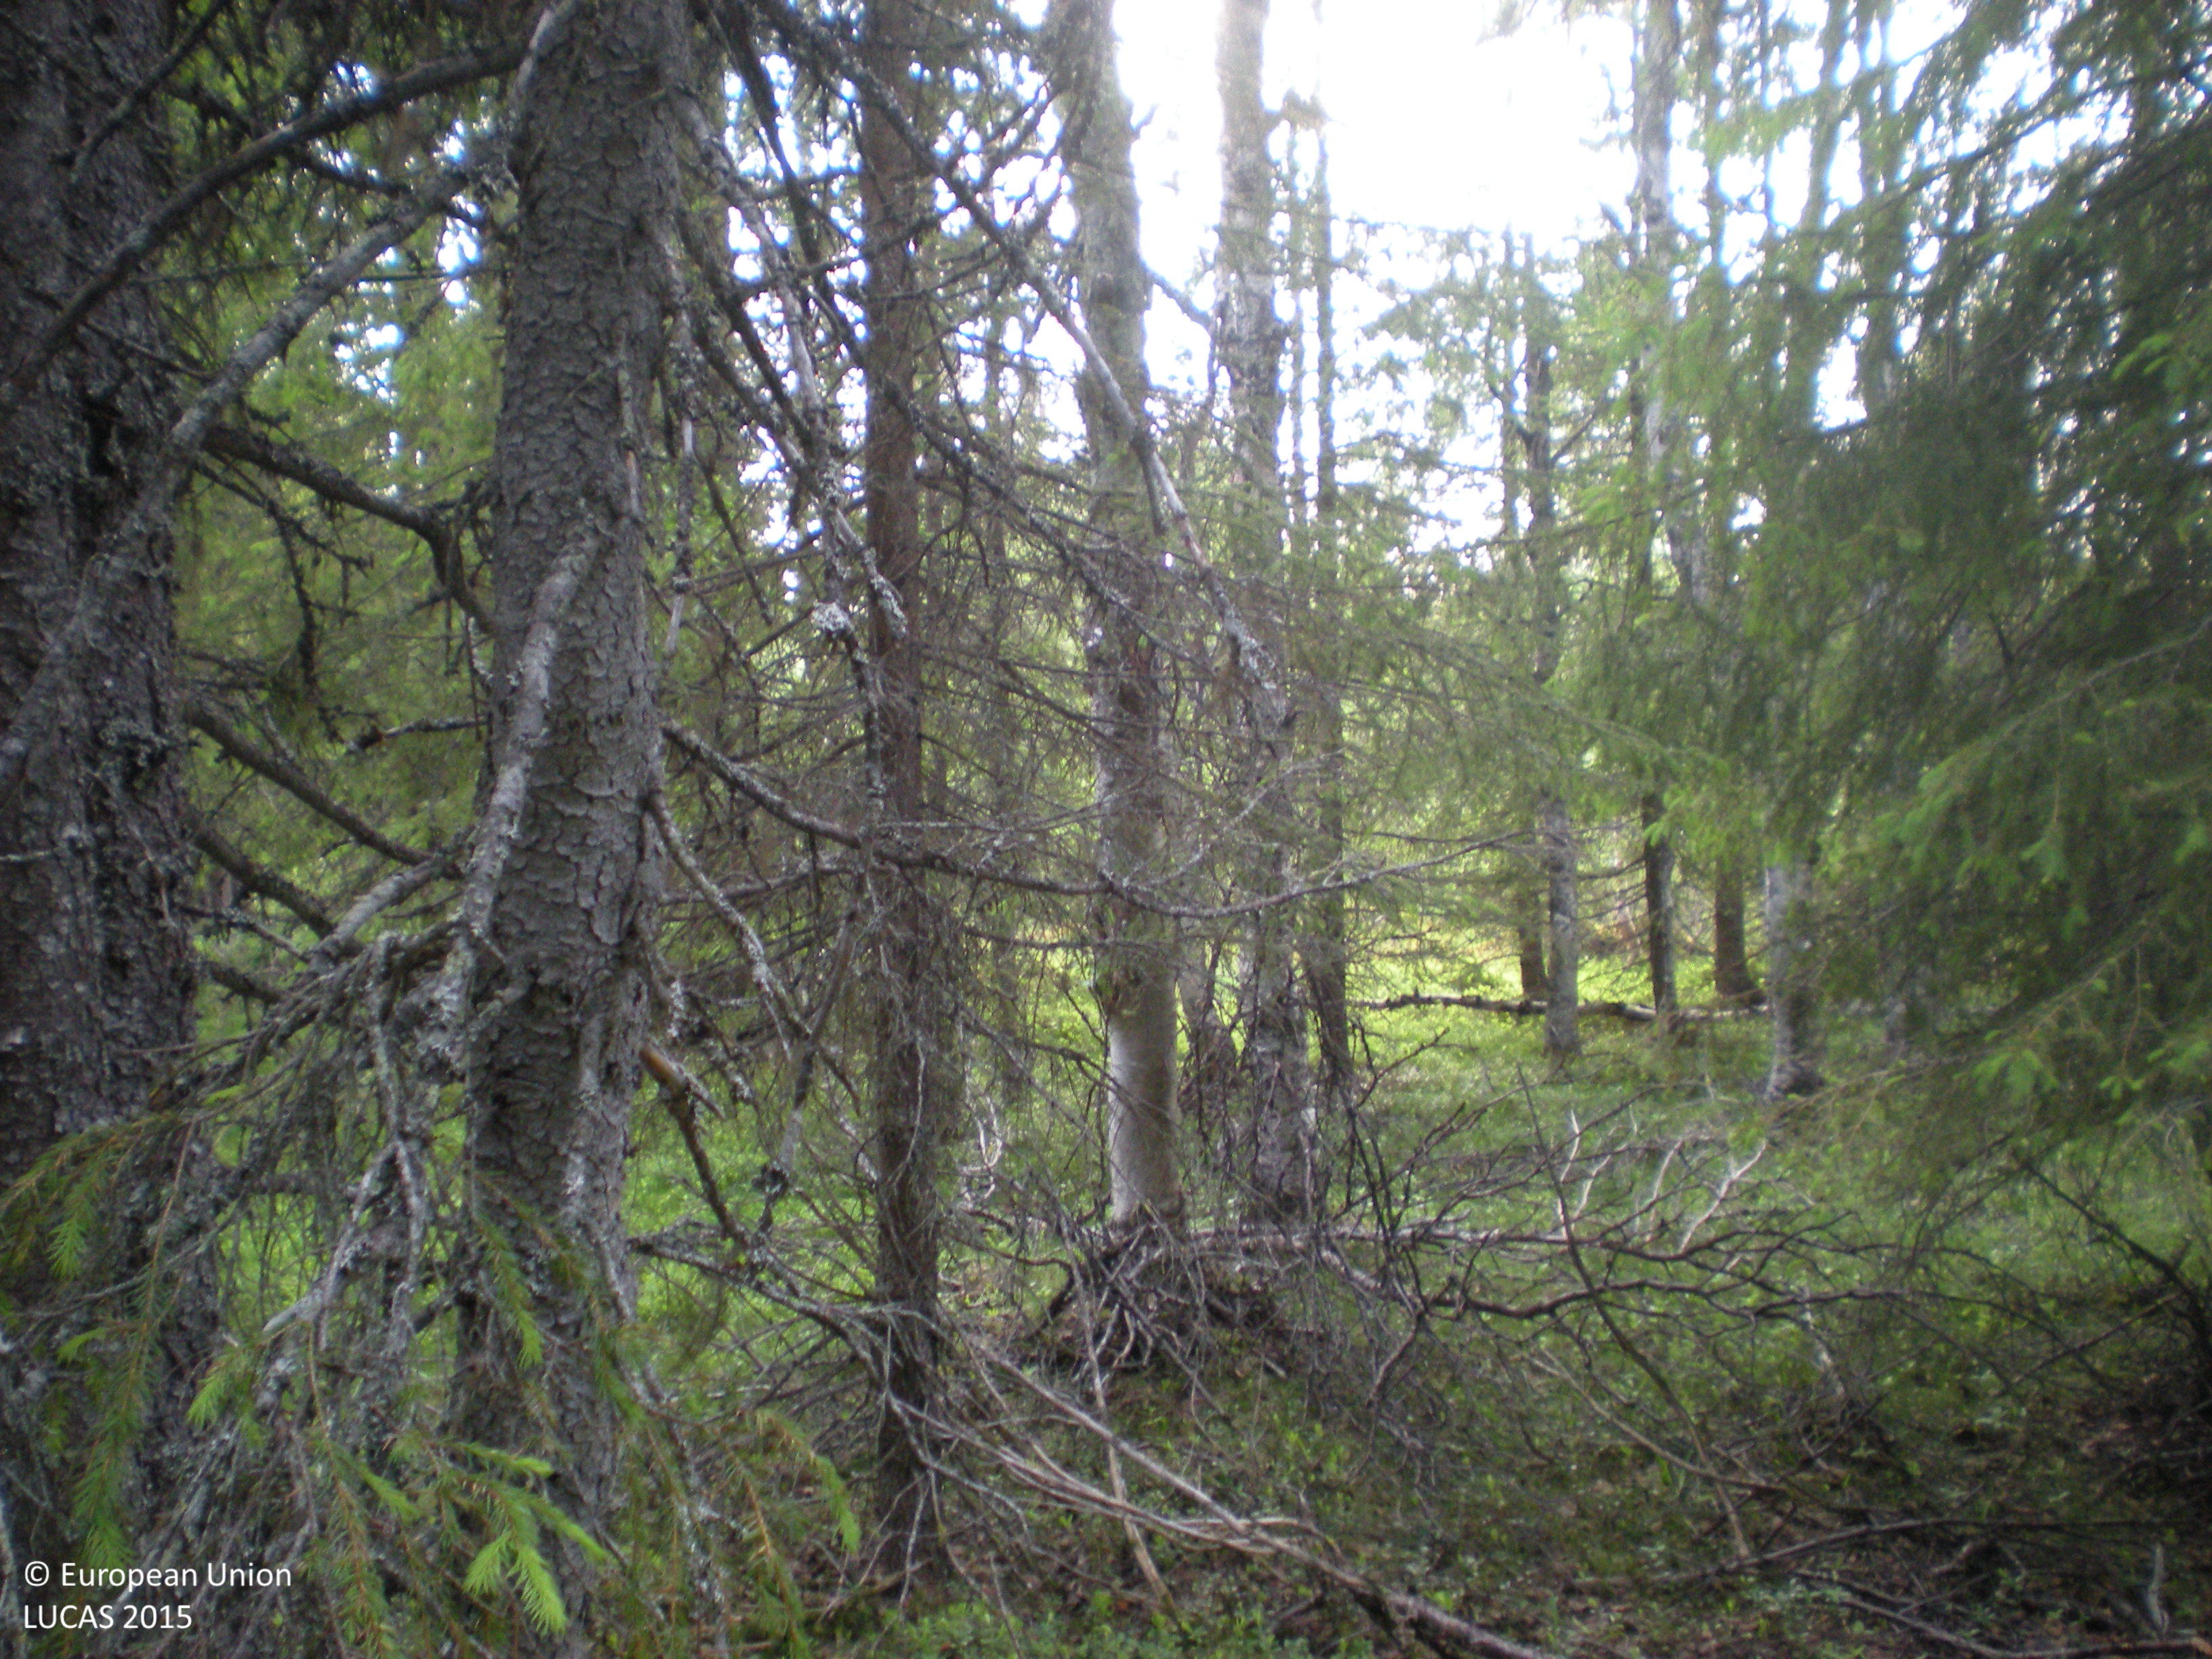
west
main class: Woodland
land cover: Spruce dominated mixed woodland
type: boreal forest
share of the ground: 50 - 75 %
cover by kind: coniferous forest trees 45 %, broadleaved forest trees 30 %, herbaceous plants 15 %, shrubs 5 %, lichens and mosses 5 %
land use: Forestry
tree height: > 5 m
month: July
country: SE
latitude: 65.6959
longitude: 16.9922
